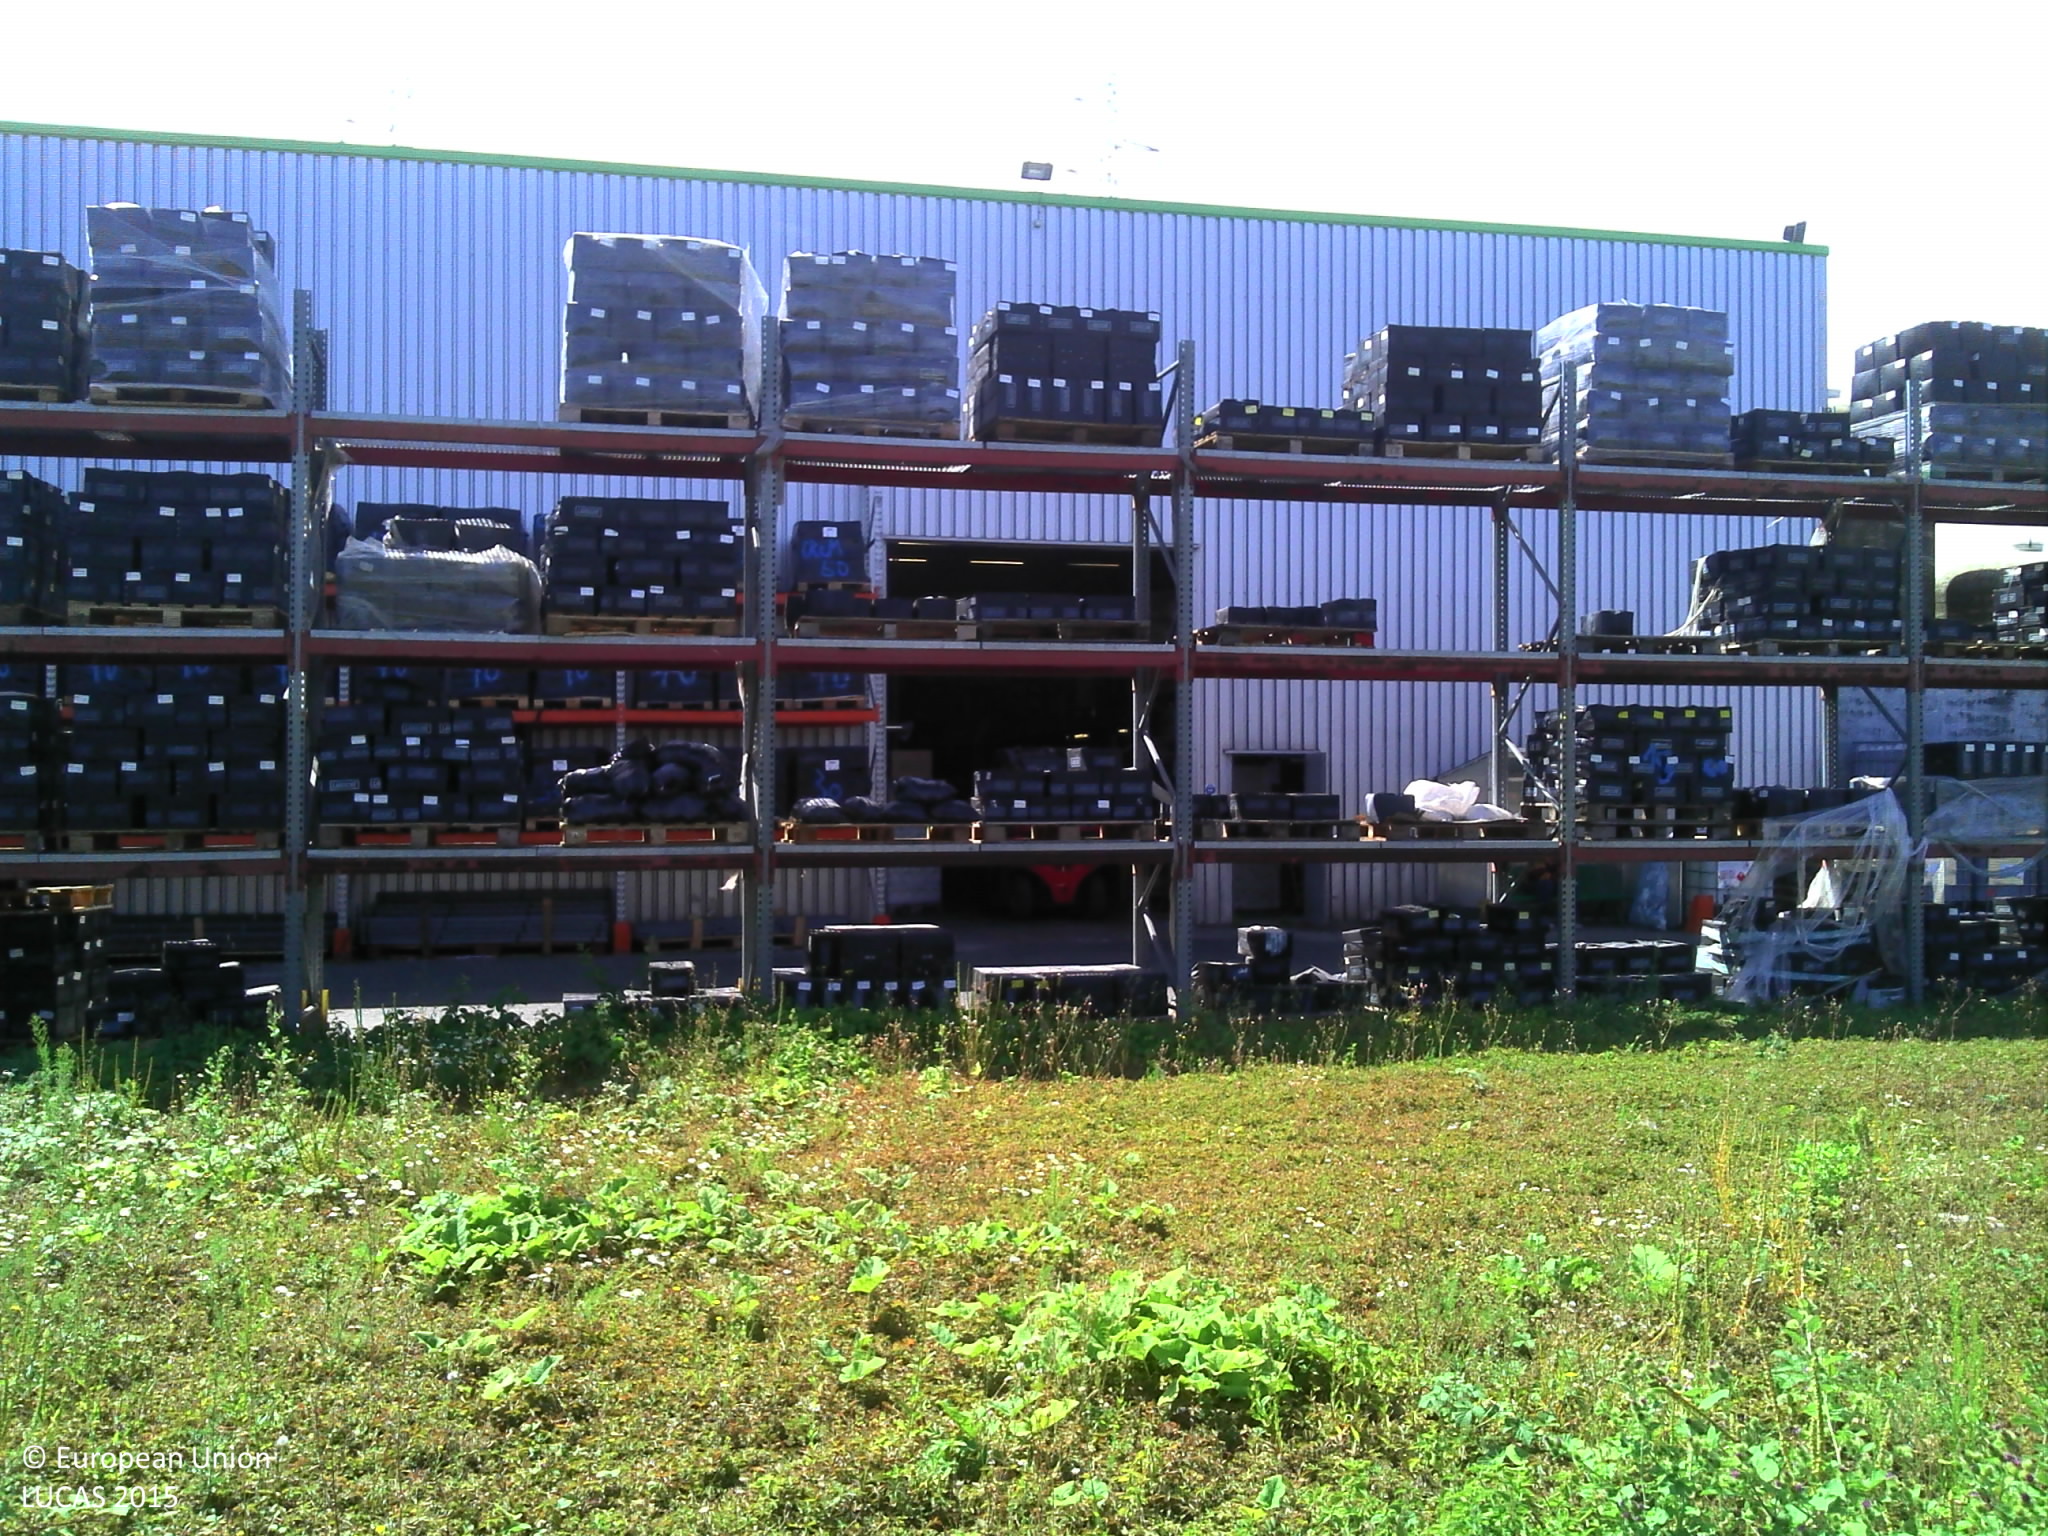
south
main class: Grassland
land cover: Spontaneously vegetated surfaces
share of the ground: > 75 %
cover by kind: herbaceous plants 90 %, consolidated bare surface 10 %
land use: Logistics and storage
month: July
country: FR
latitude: 48.6230
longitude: 2.5686
